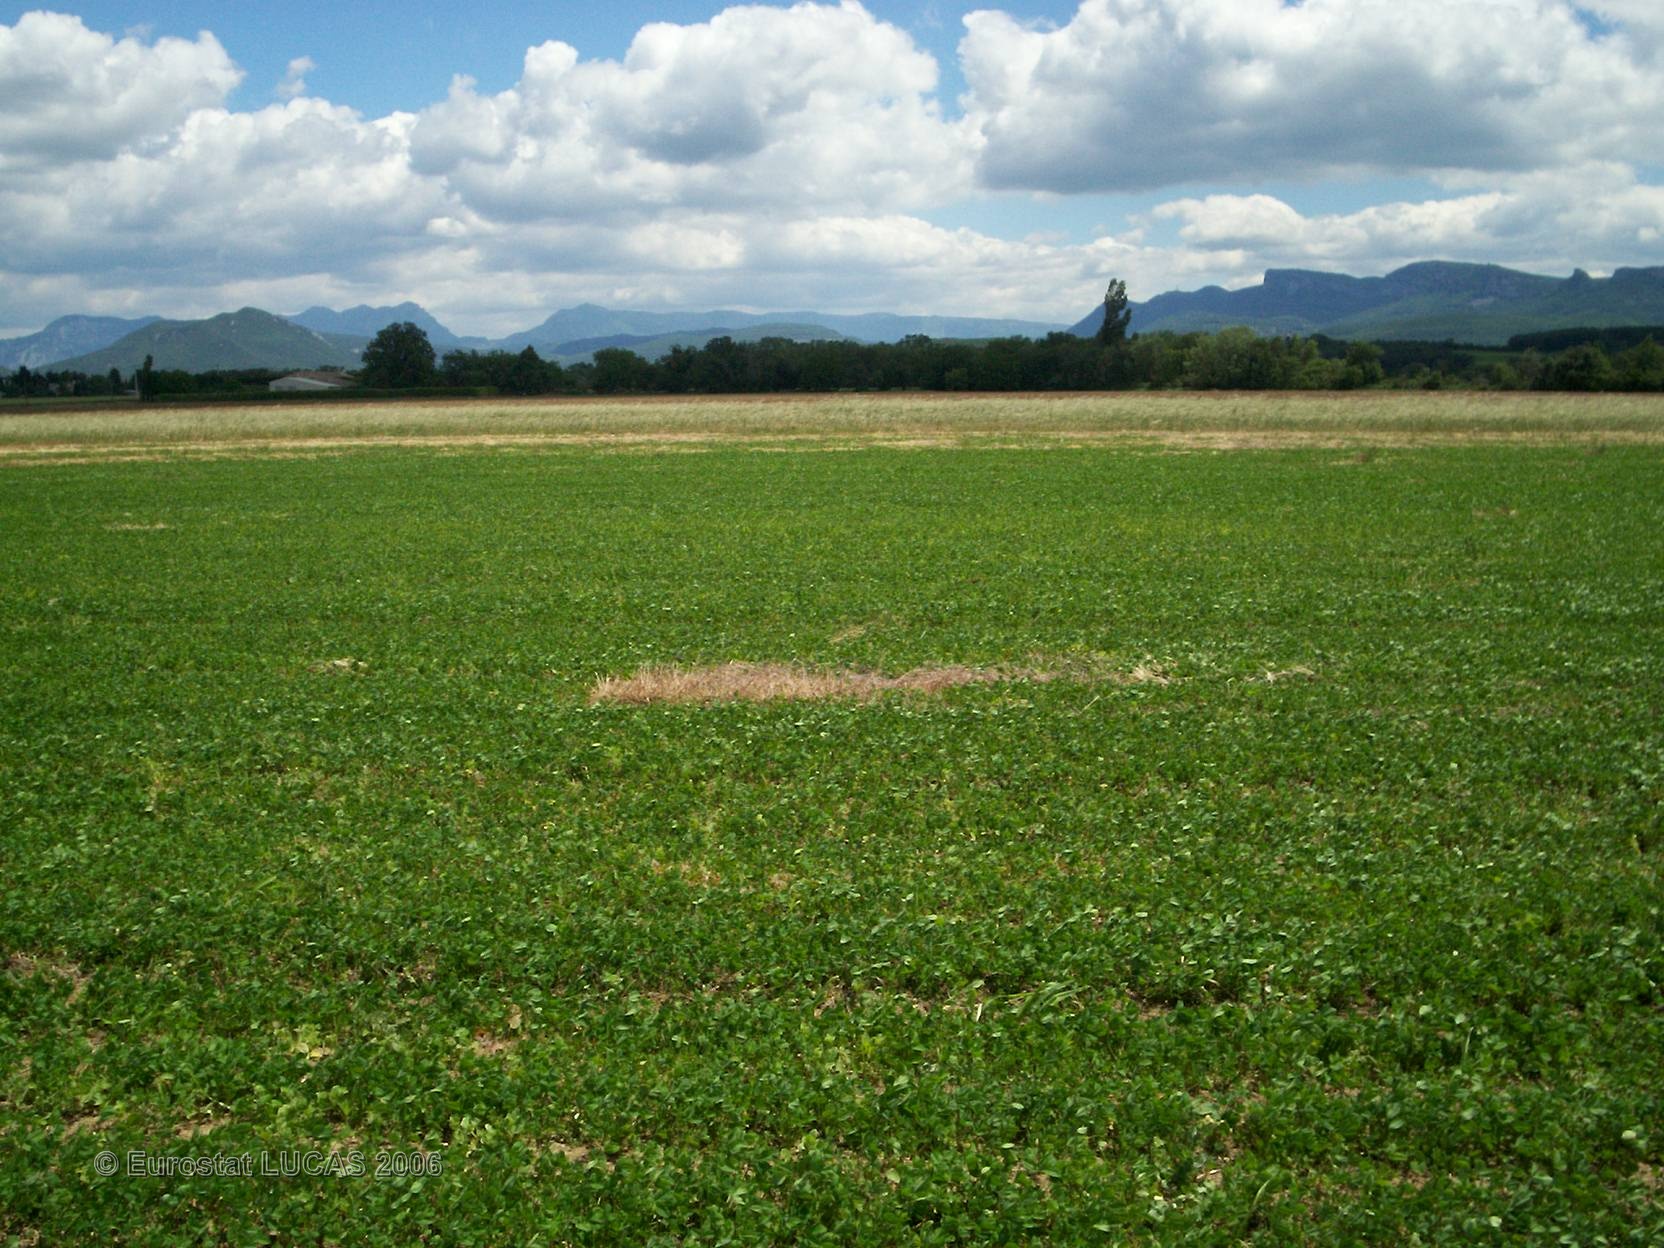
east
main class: Cropland
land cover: Clovers
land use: Agriculture (excluding fallow land and kitchen gardens)
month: May
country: FR
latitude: 44.5868
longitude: 4.9054
